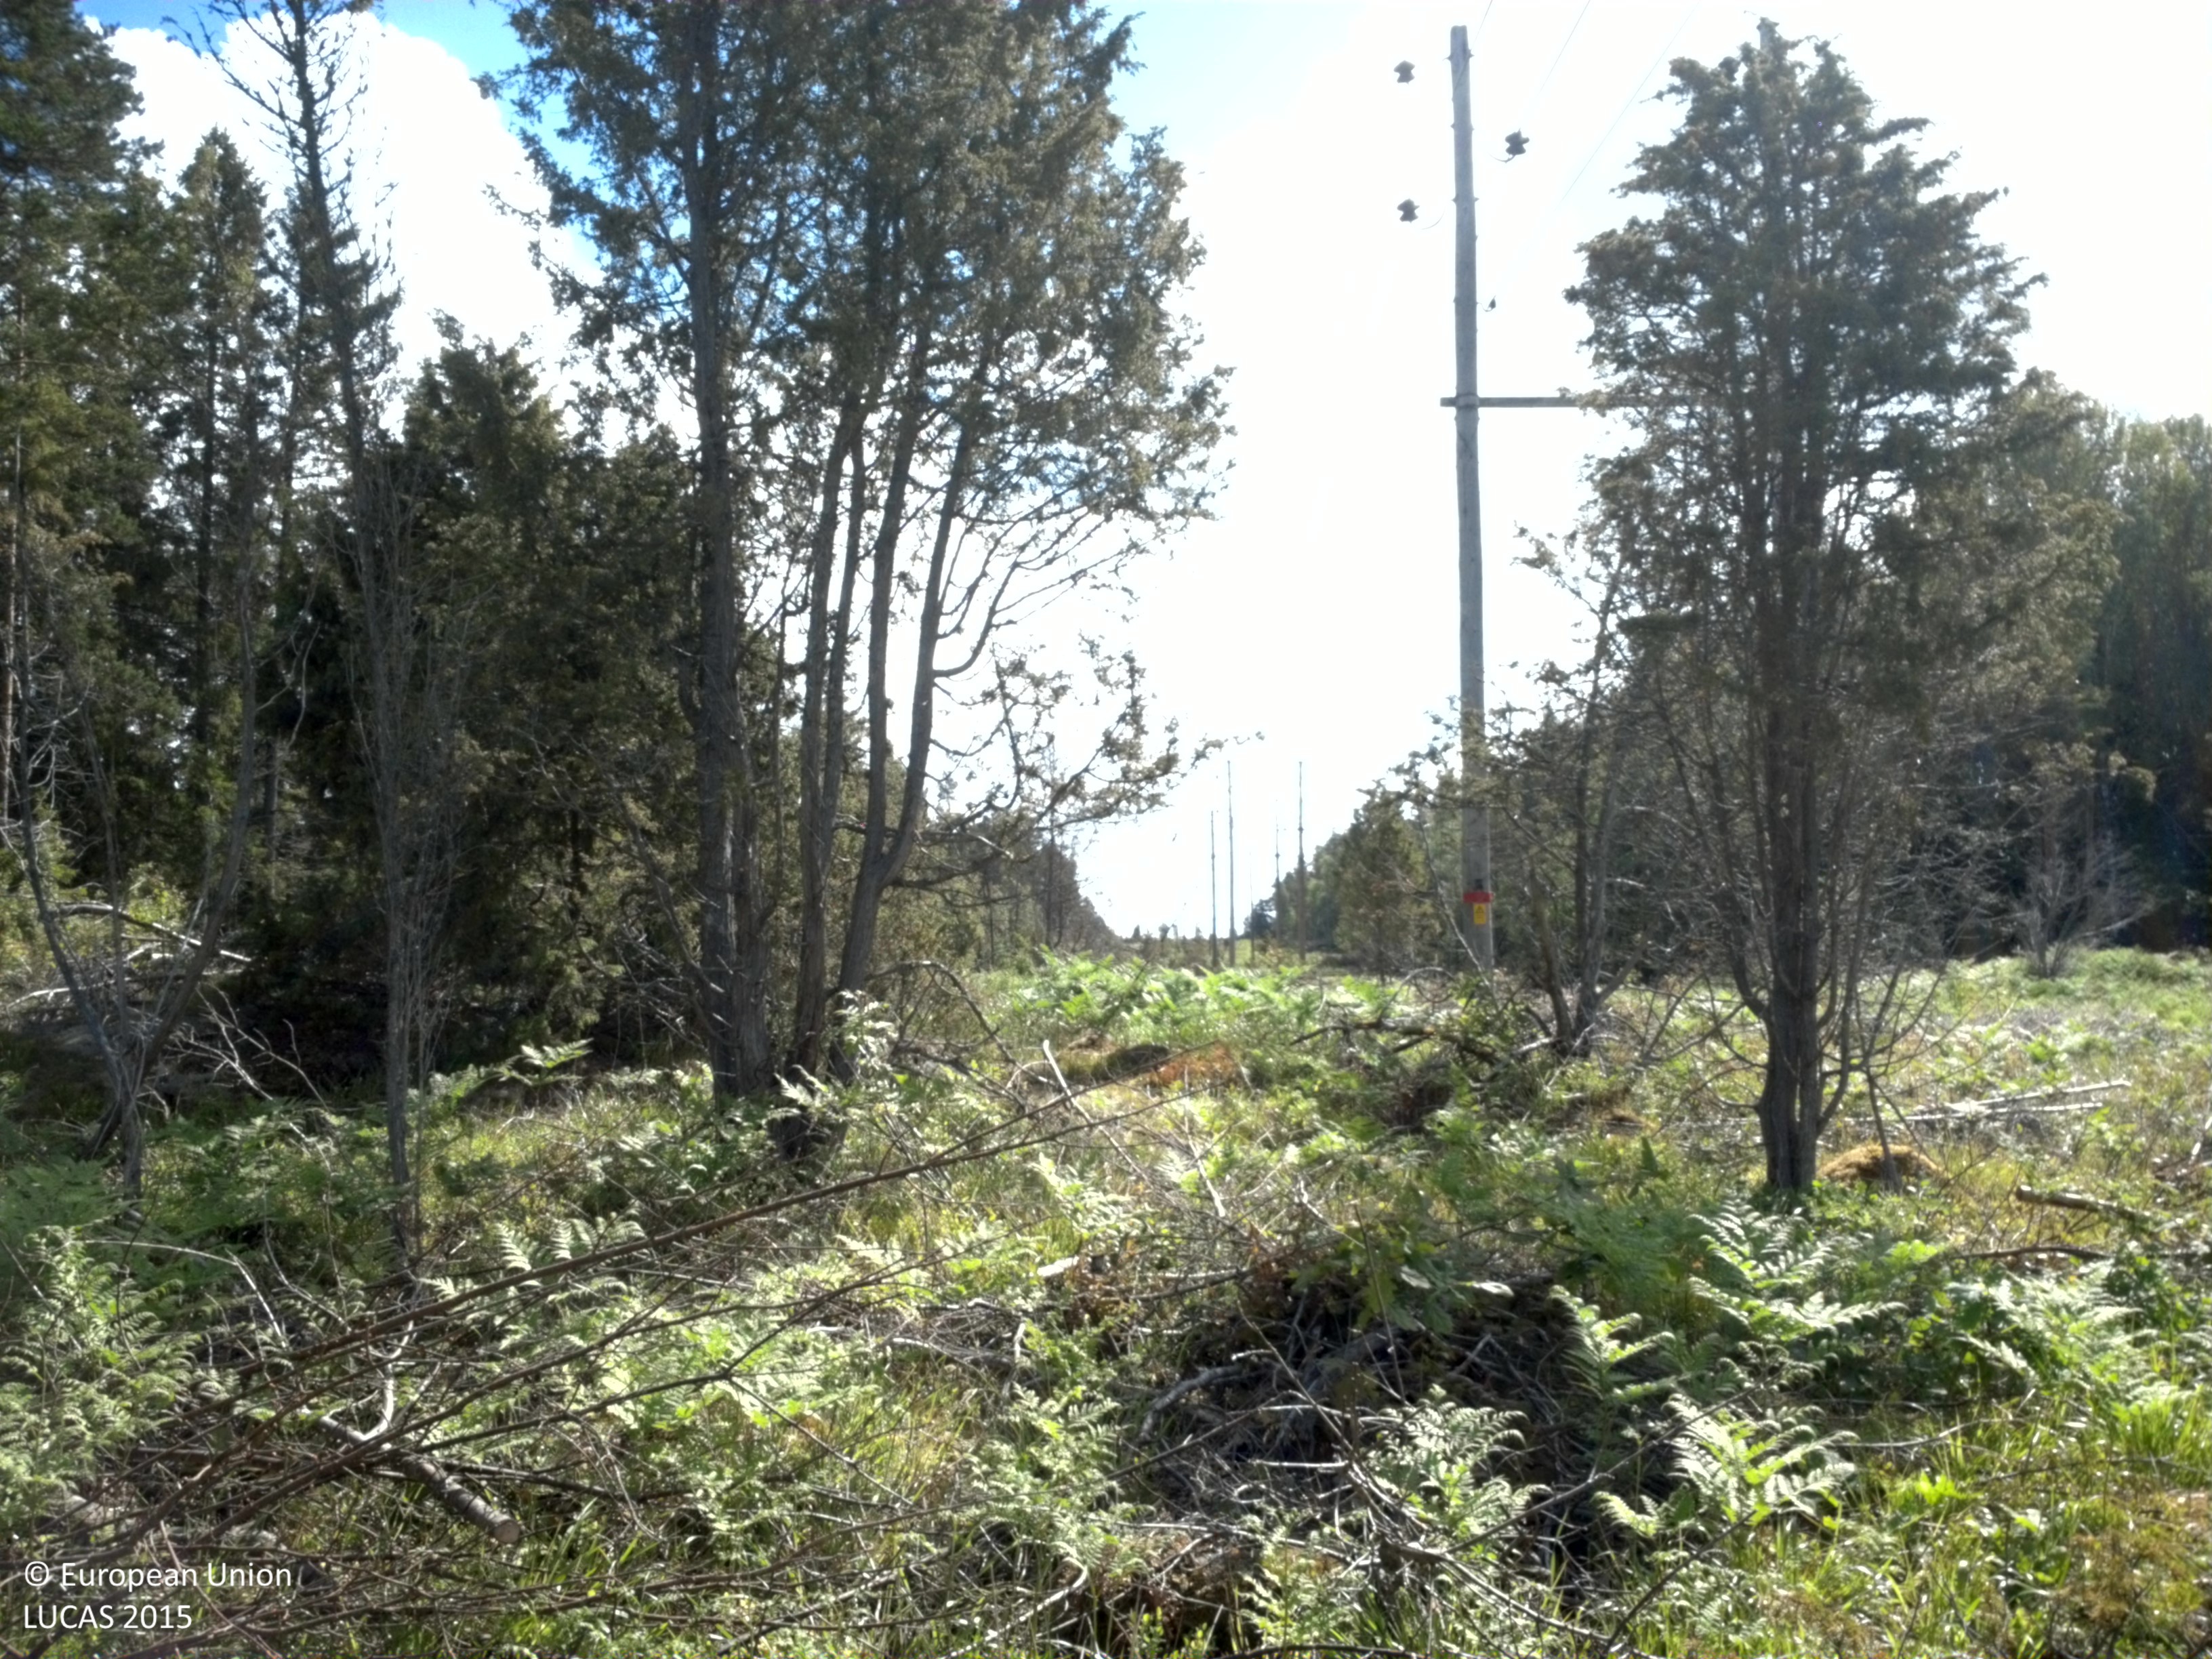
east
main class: Shrubland
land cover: Shrubland without tree cover
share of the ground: 10 - 25 %
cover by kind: herbaceous plants 65 %, shrubs 25 %, lichens and mosses 10 %
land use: Telecommunication
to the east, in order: Shrubland without tree cover; Electric lines; Shrubland without tree cover; Ditches and canals; Electric lines; Paved roads, cycling and walking lanes; Ditches and canals; Shrubland without tree cover
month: June
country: SE
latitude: 60.0560
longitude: 18.7094
